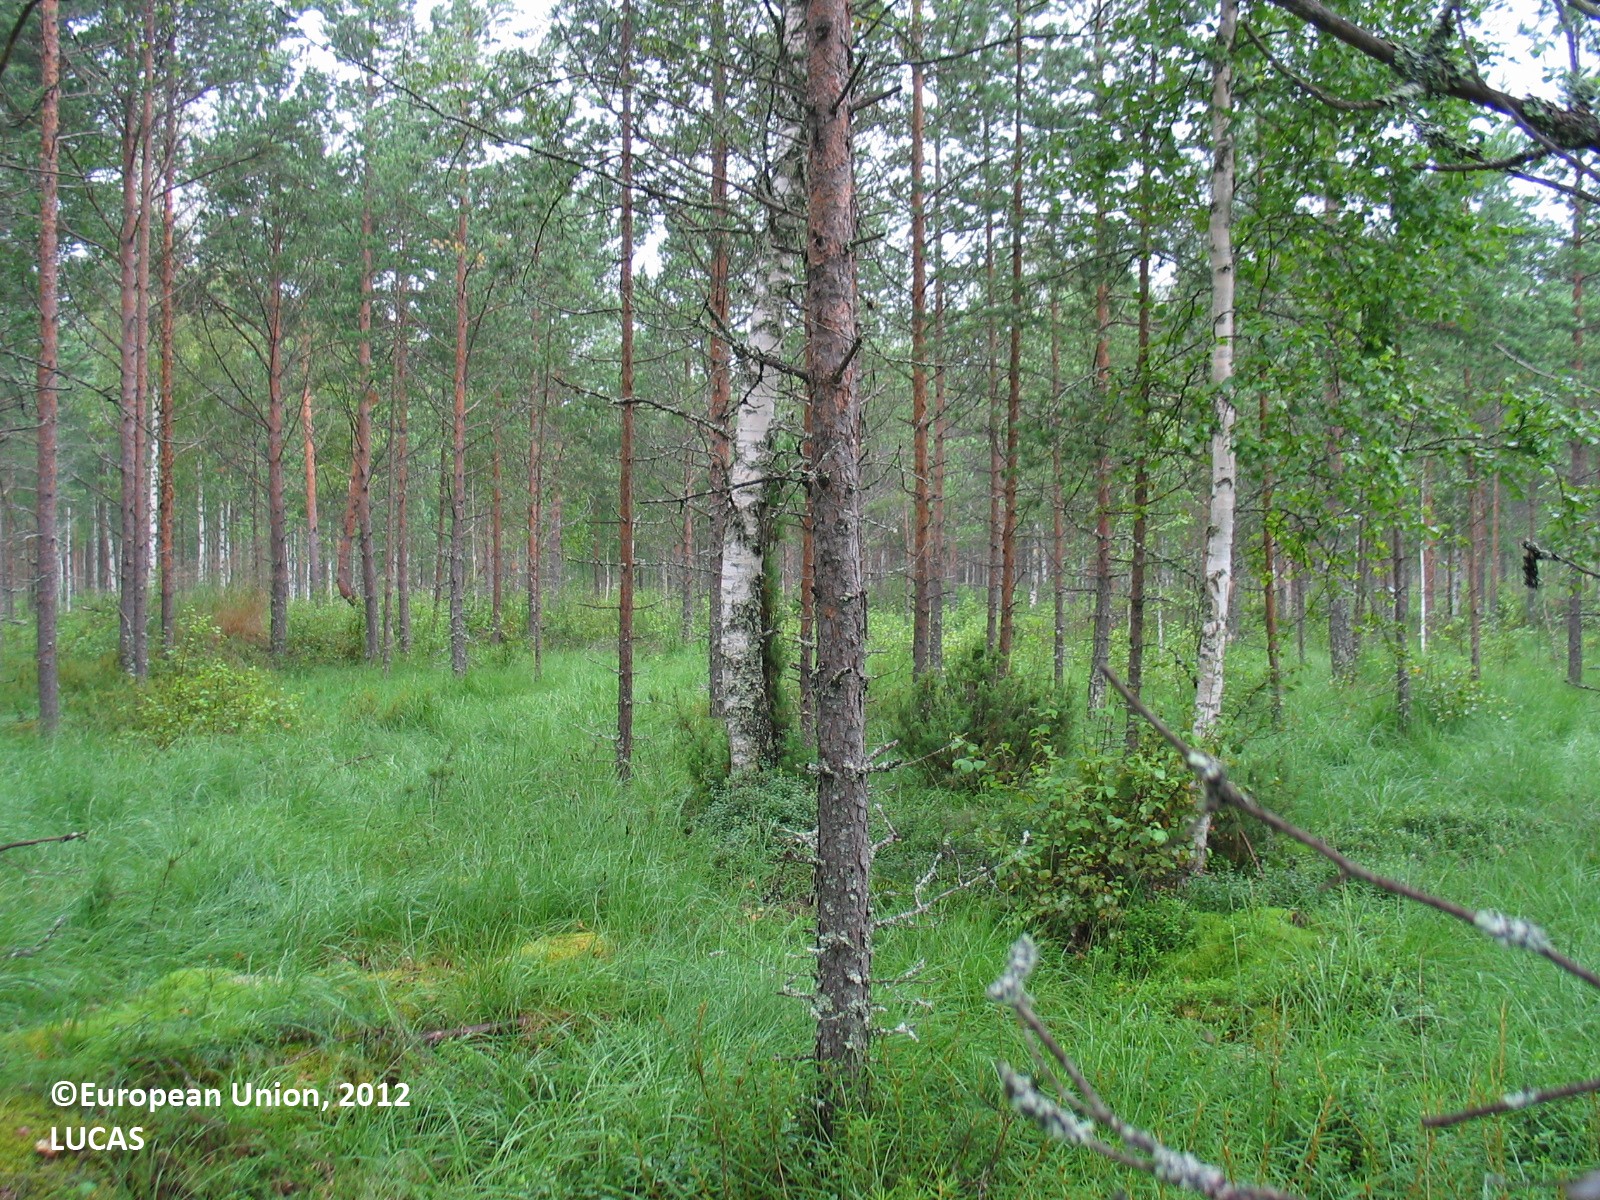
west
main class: Woodland
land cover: Pine dominated mixed woodland
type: mire and swamp forests
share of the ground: 25 - 50 %
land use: Forestry
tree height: > 5 m
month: August
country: FI
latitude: 64.5969
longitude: 25.9997
